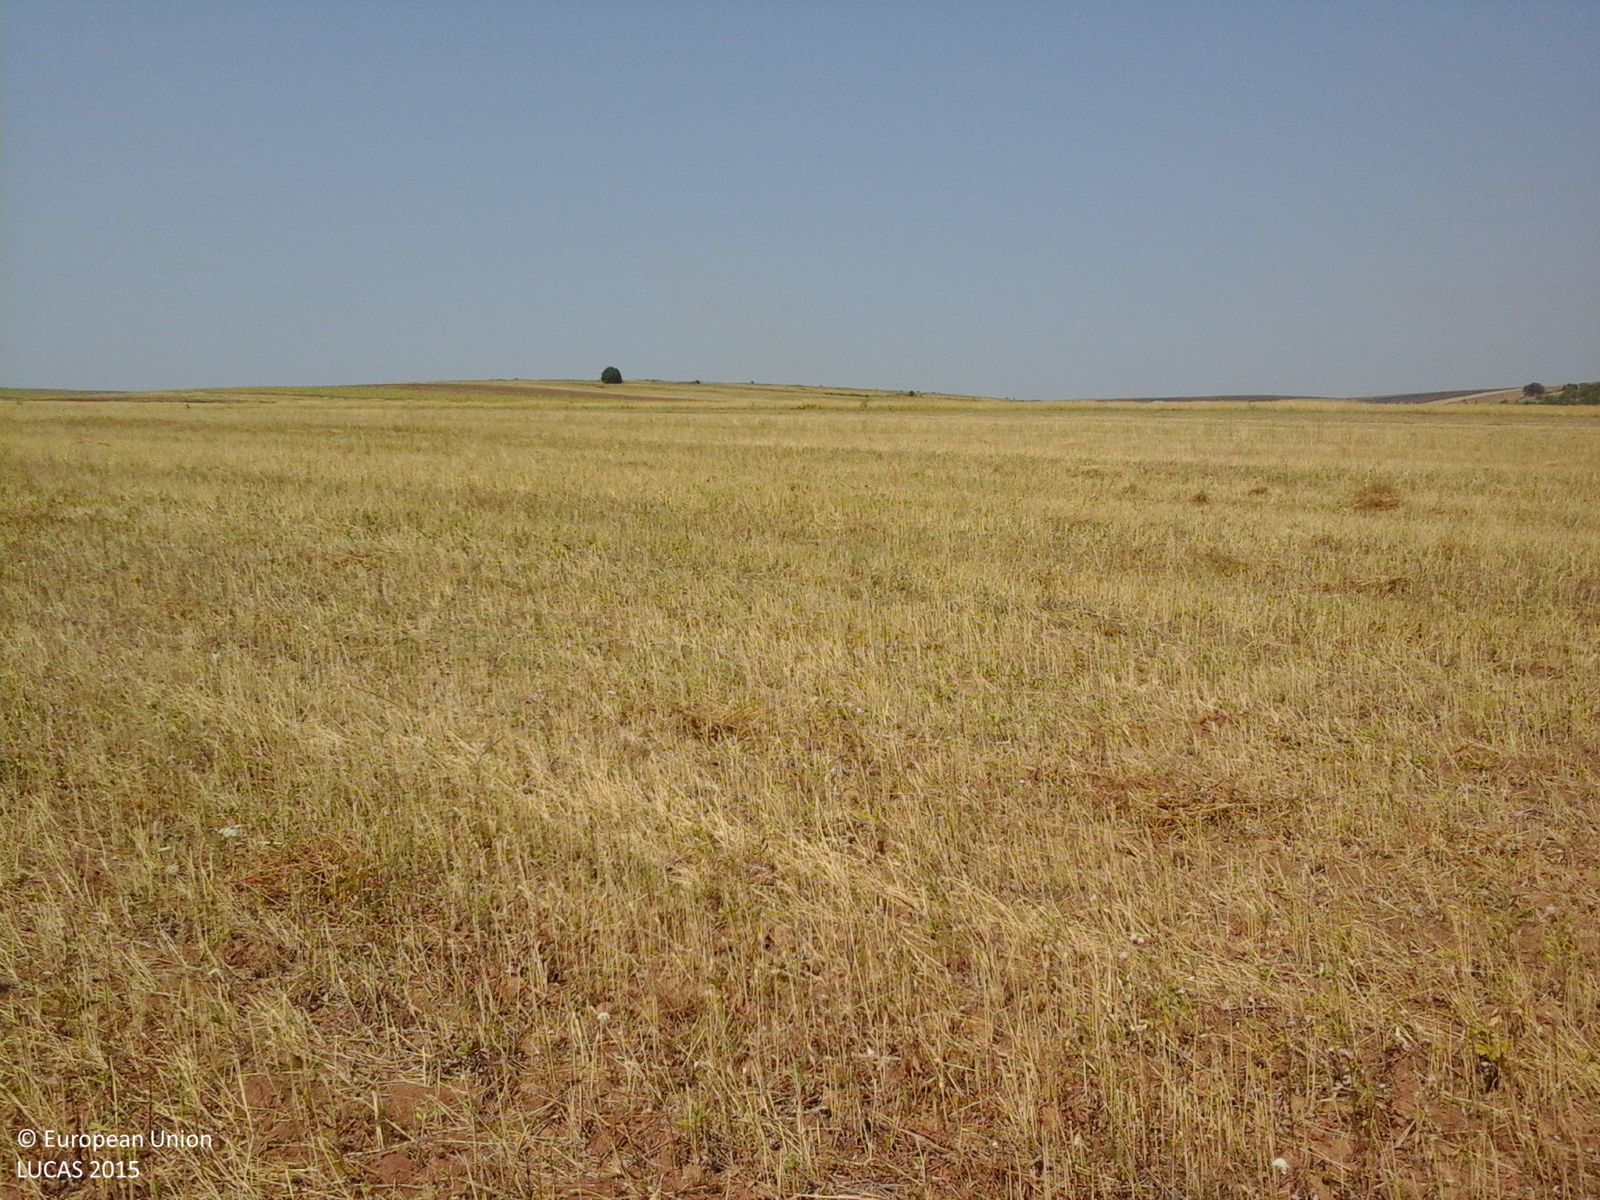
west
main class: Cropland
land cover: Durum wheat
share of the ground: > 75 %
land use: Agriculture (excluding fallow land and kitchen gardens)
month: August
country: RO
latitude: 44.4268
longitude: 22.9700
